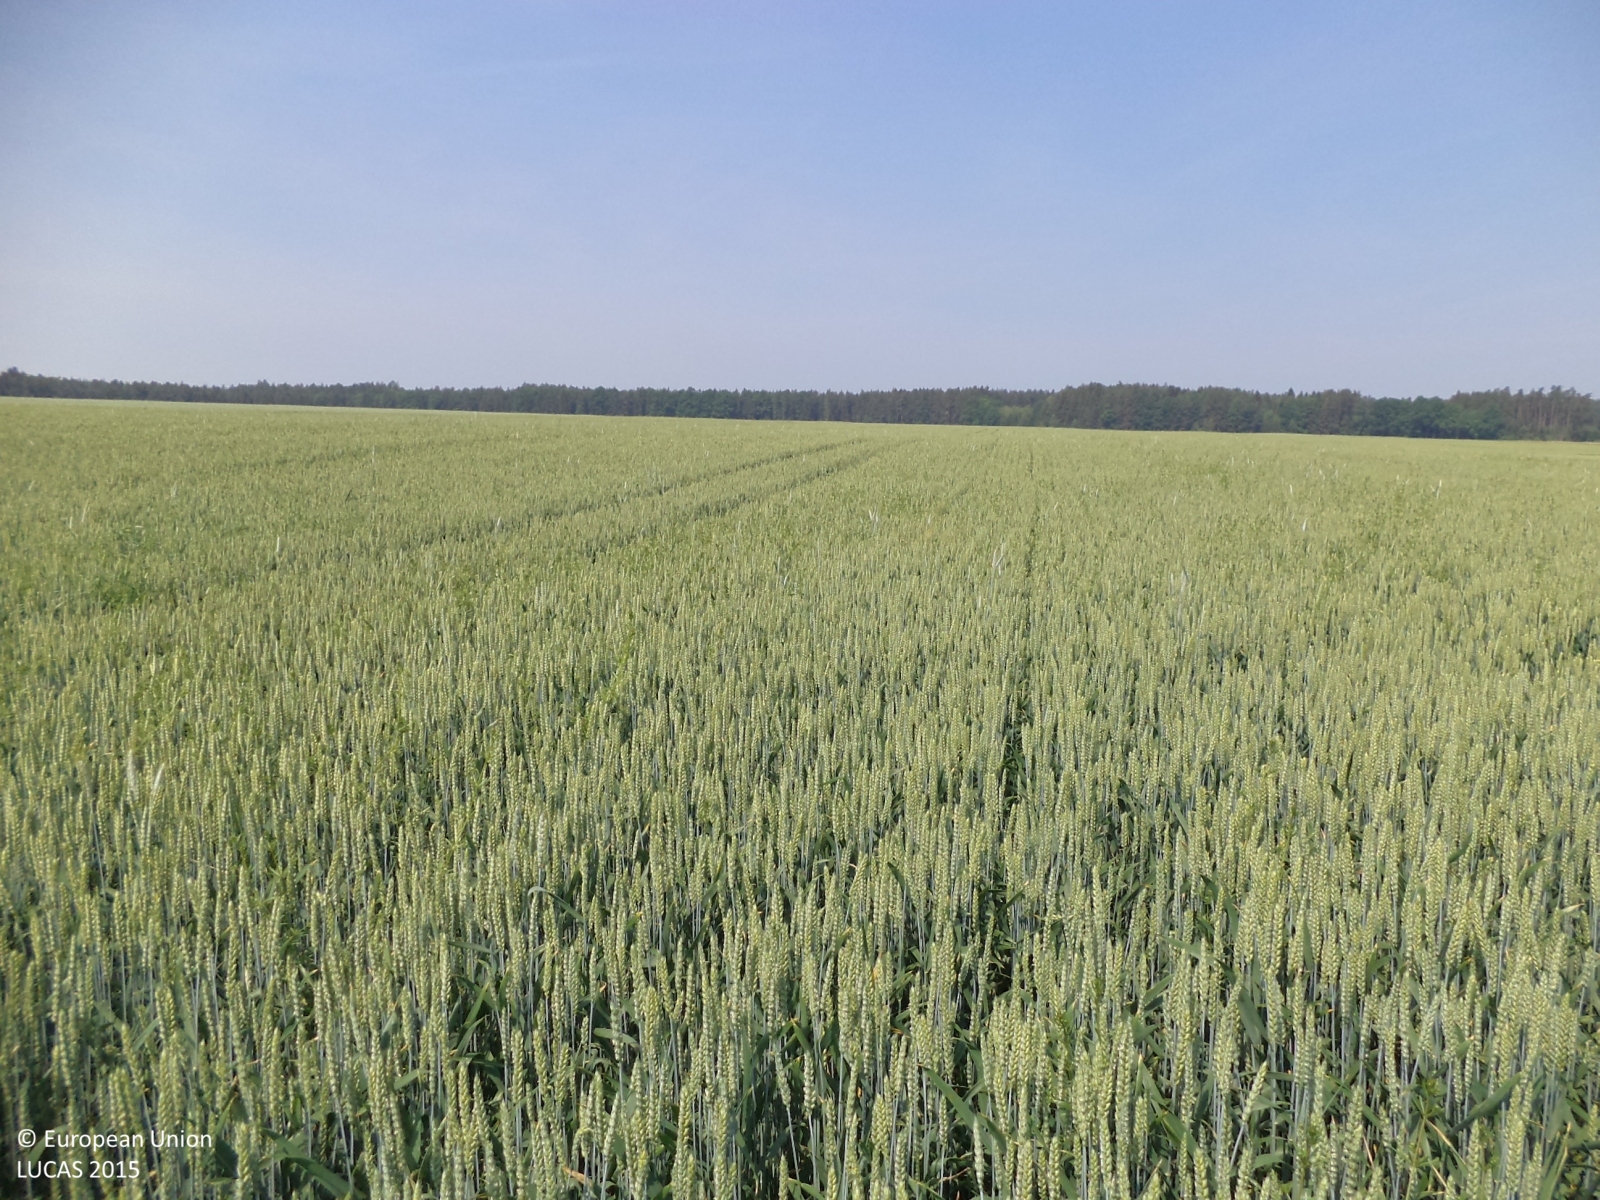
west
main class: Cropland
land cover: Common wheat
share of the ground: > 75 %
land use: Agriculture (excluding fallow land and kitchen gardens)
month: June
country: CZ
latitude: 49.3590
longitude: 14.4485
